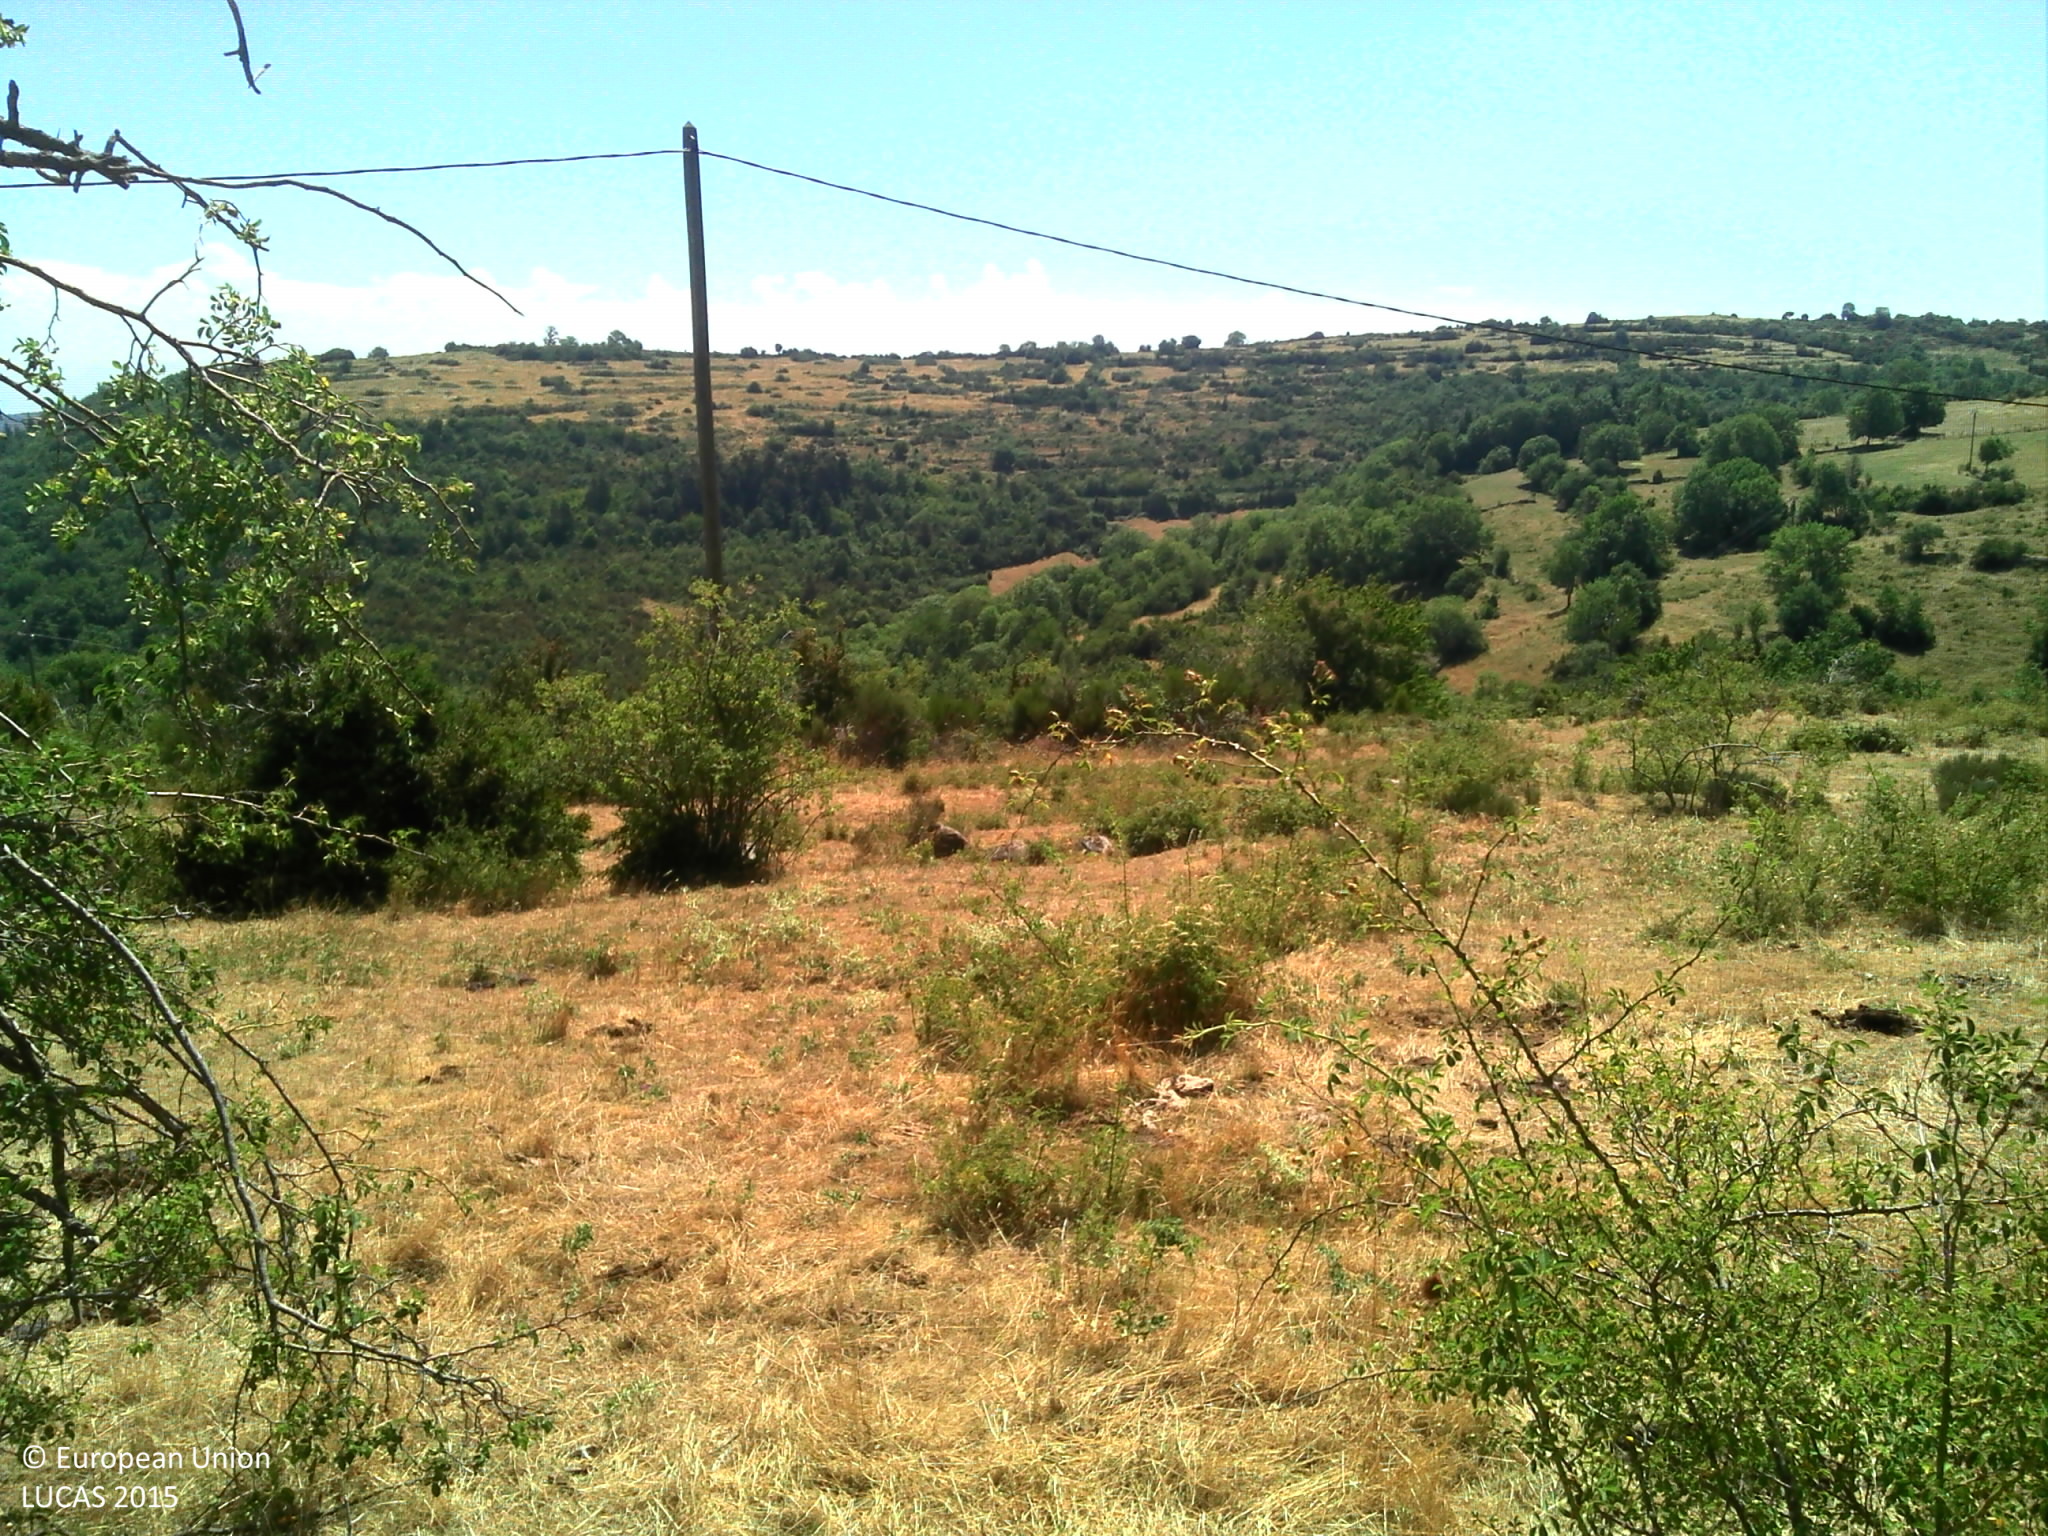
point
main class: Grassland
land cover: Grassland with sparse tree/shrub cover
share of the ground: > 75 %
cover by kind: herbaceous plants 95 %, broadleaved forest trees 5 %
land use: Agriculture (excluding fallow land and kitchen gardens)
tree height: < 5 m
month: July
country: FR
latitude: 44.6782
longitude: 4.5689
